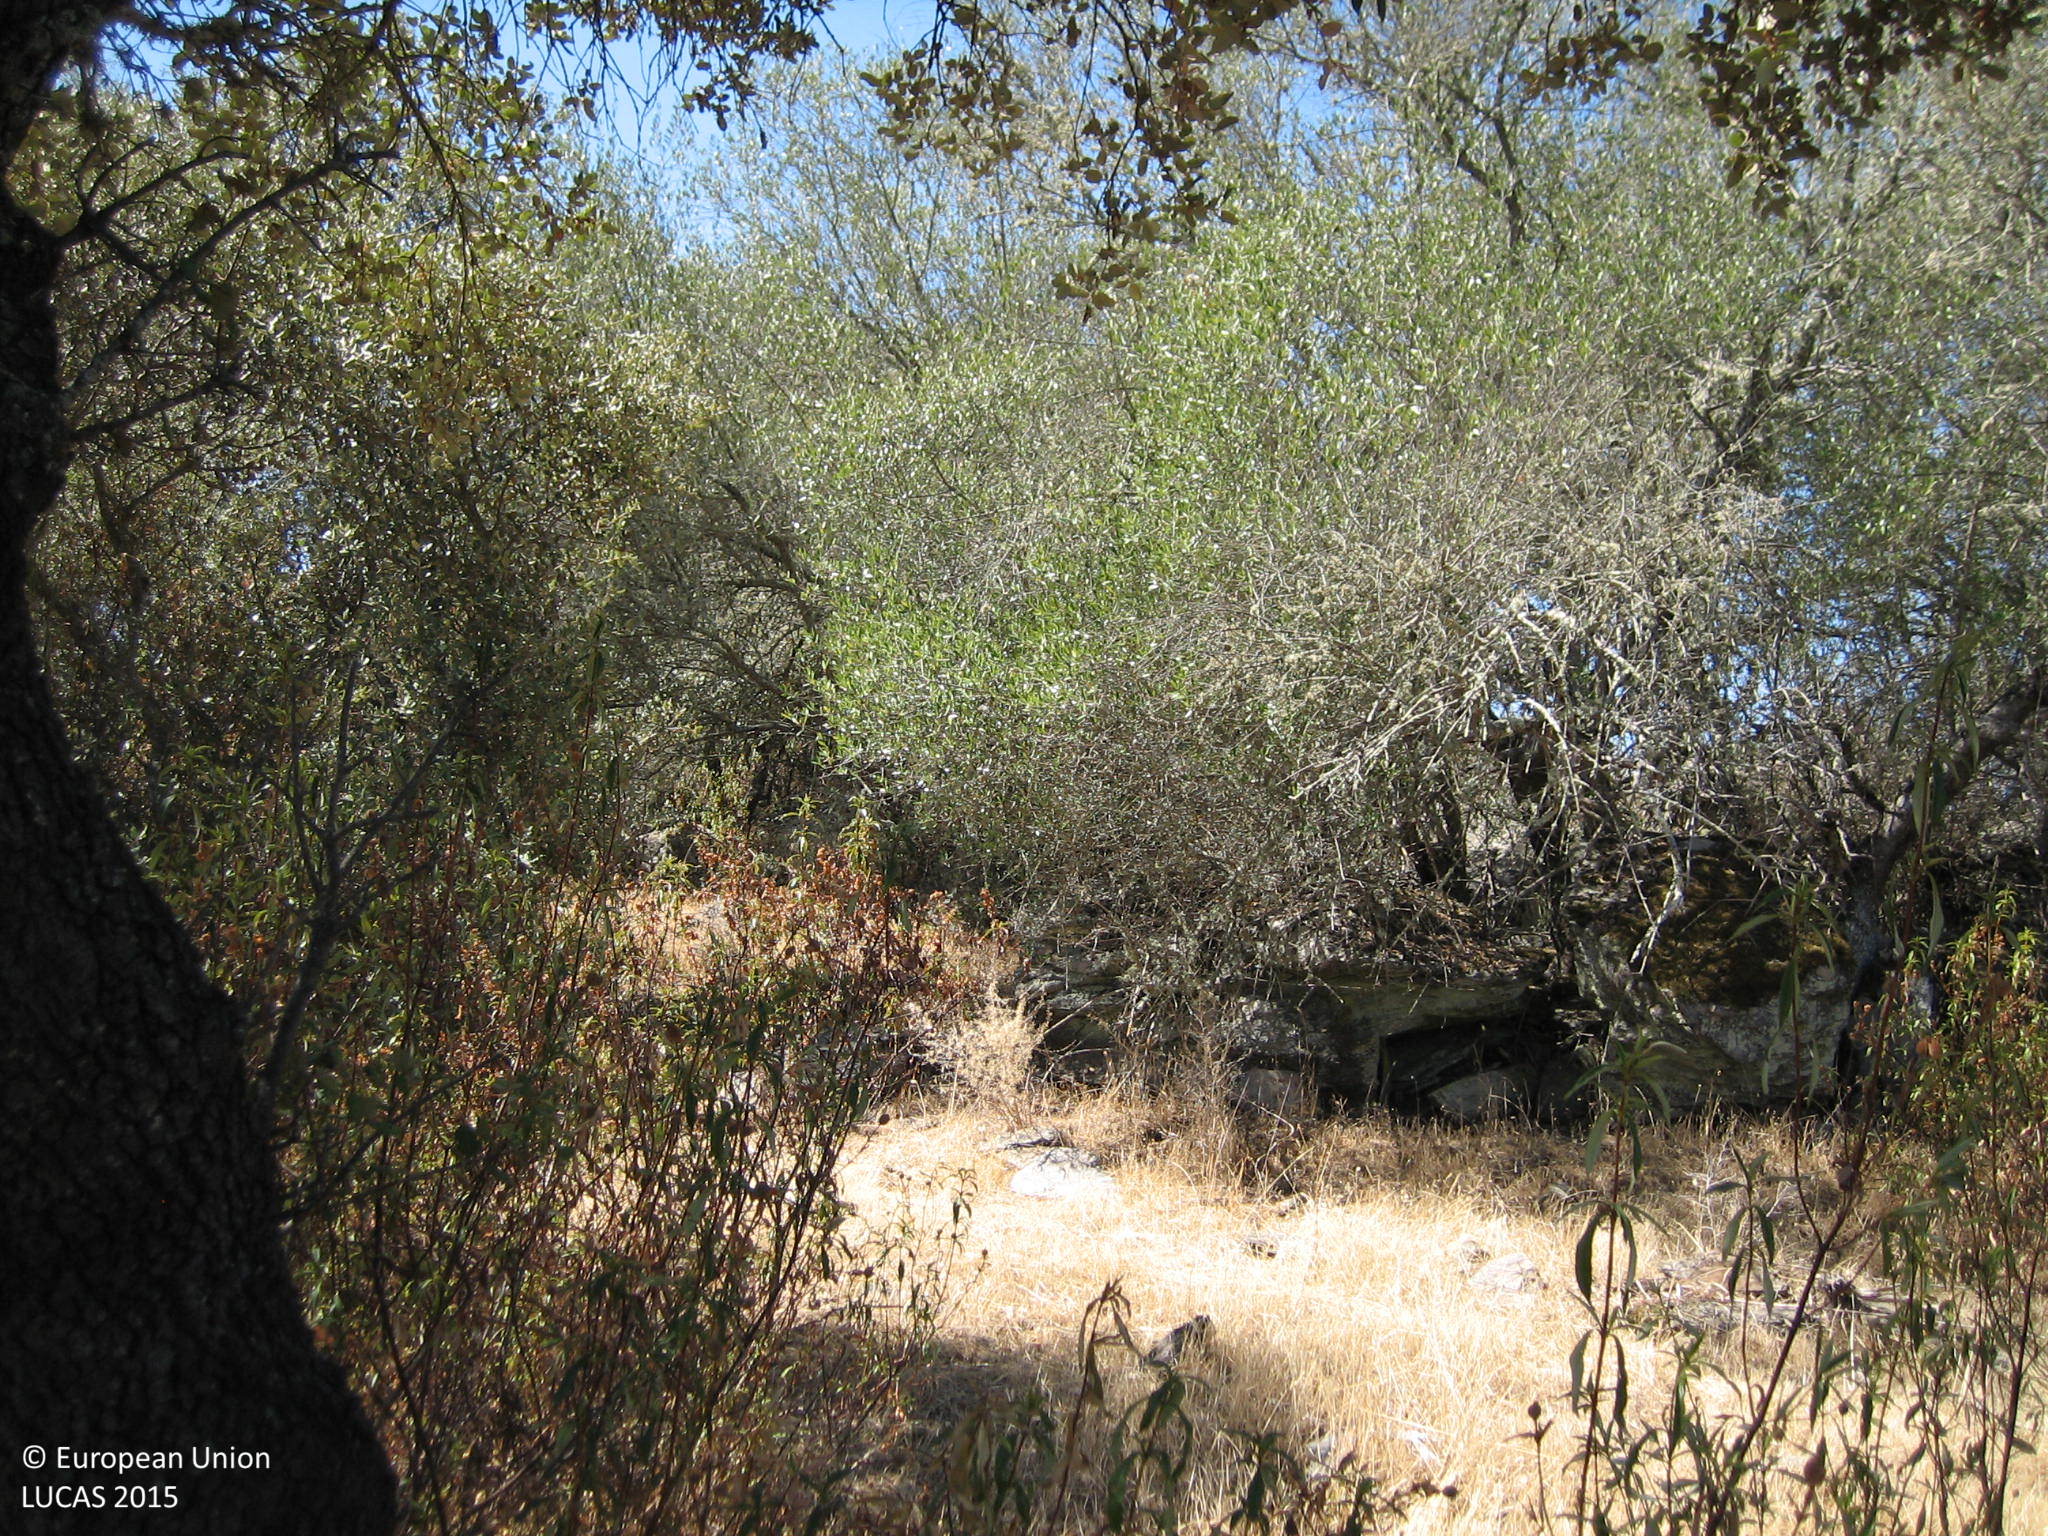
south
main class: Shrubland
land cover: Shrubland with sparse tree cover
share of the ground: 50 - 75 %
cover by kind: shrubs 60 %, herbaceous plants 35 %, broadleaved forest trees 5 %
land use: Agriculture (excluding fallow land and kitchen gardens)
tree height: < 5 m
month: August
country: ES
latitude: 38.4546
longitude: -7.2217
